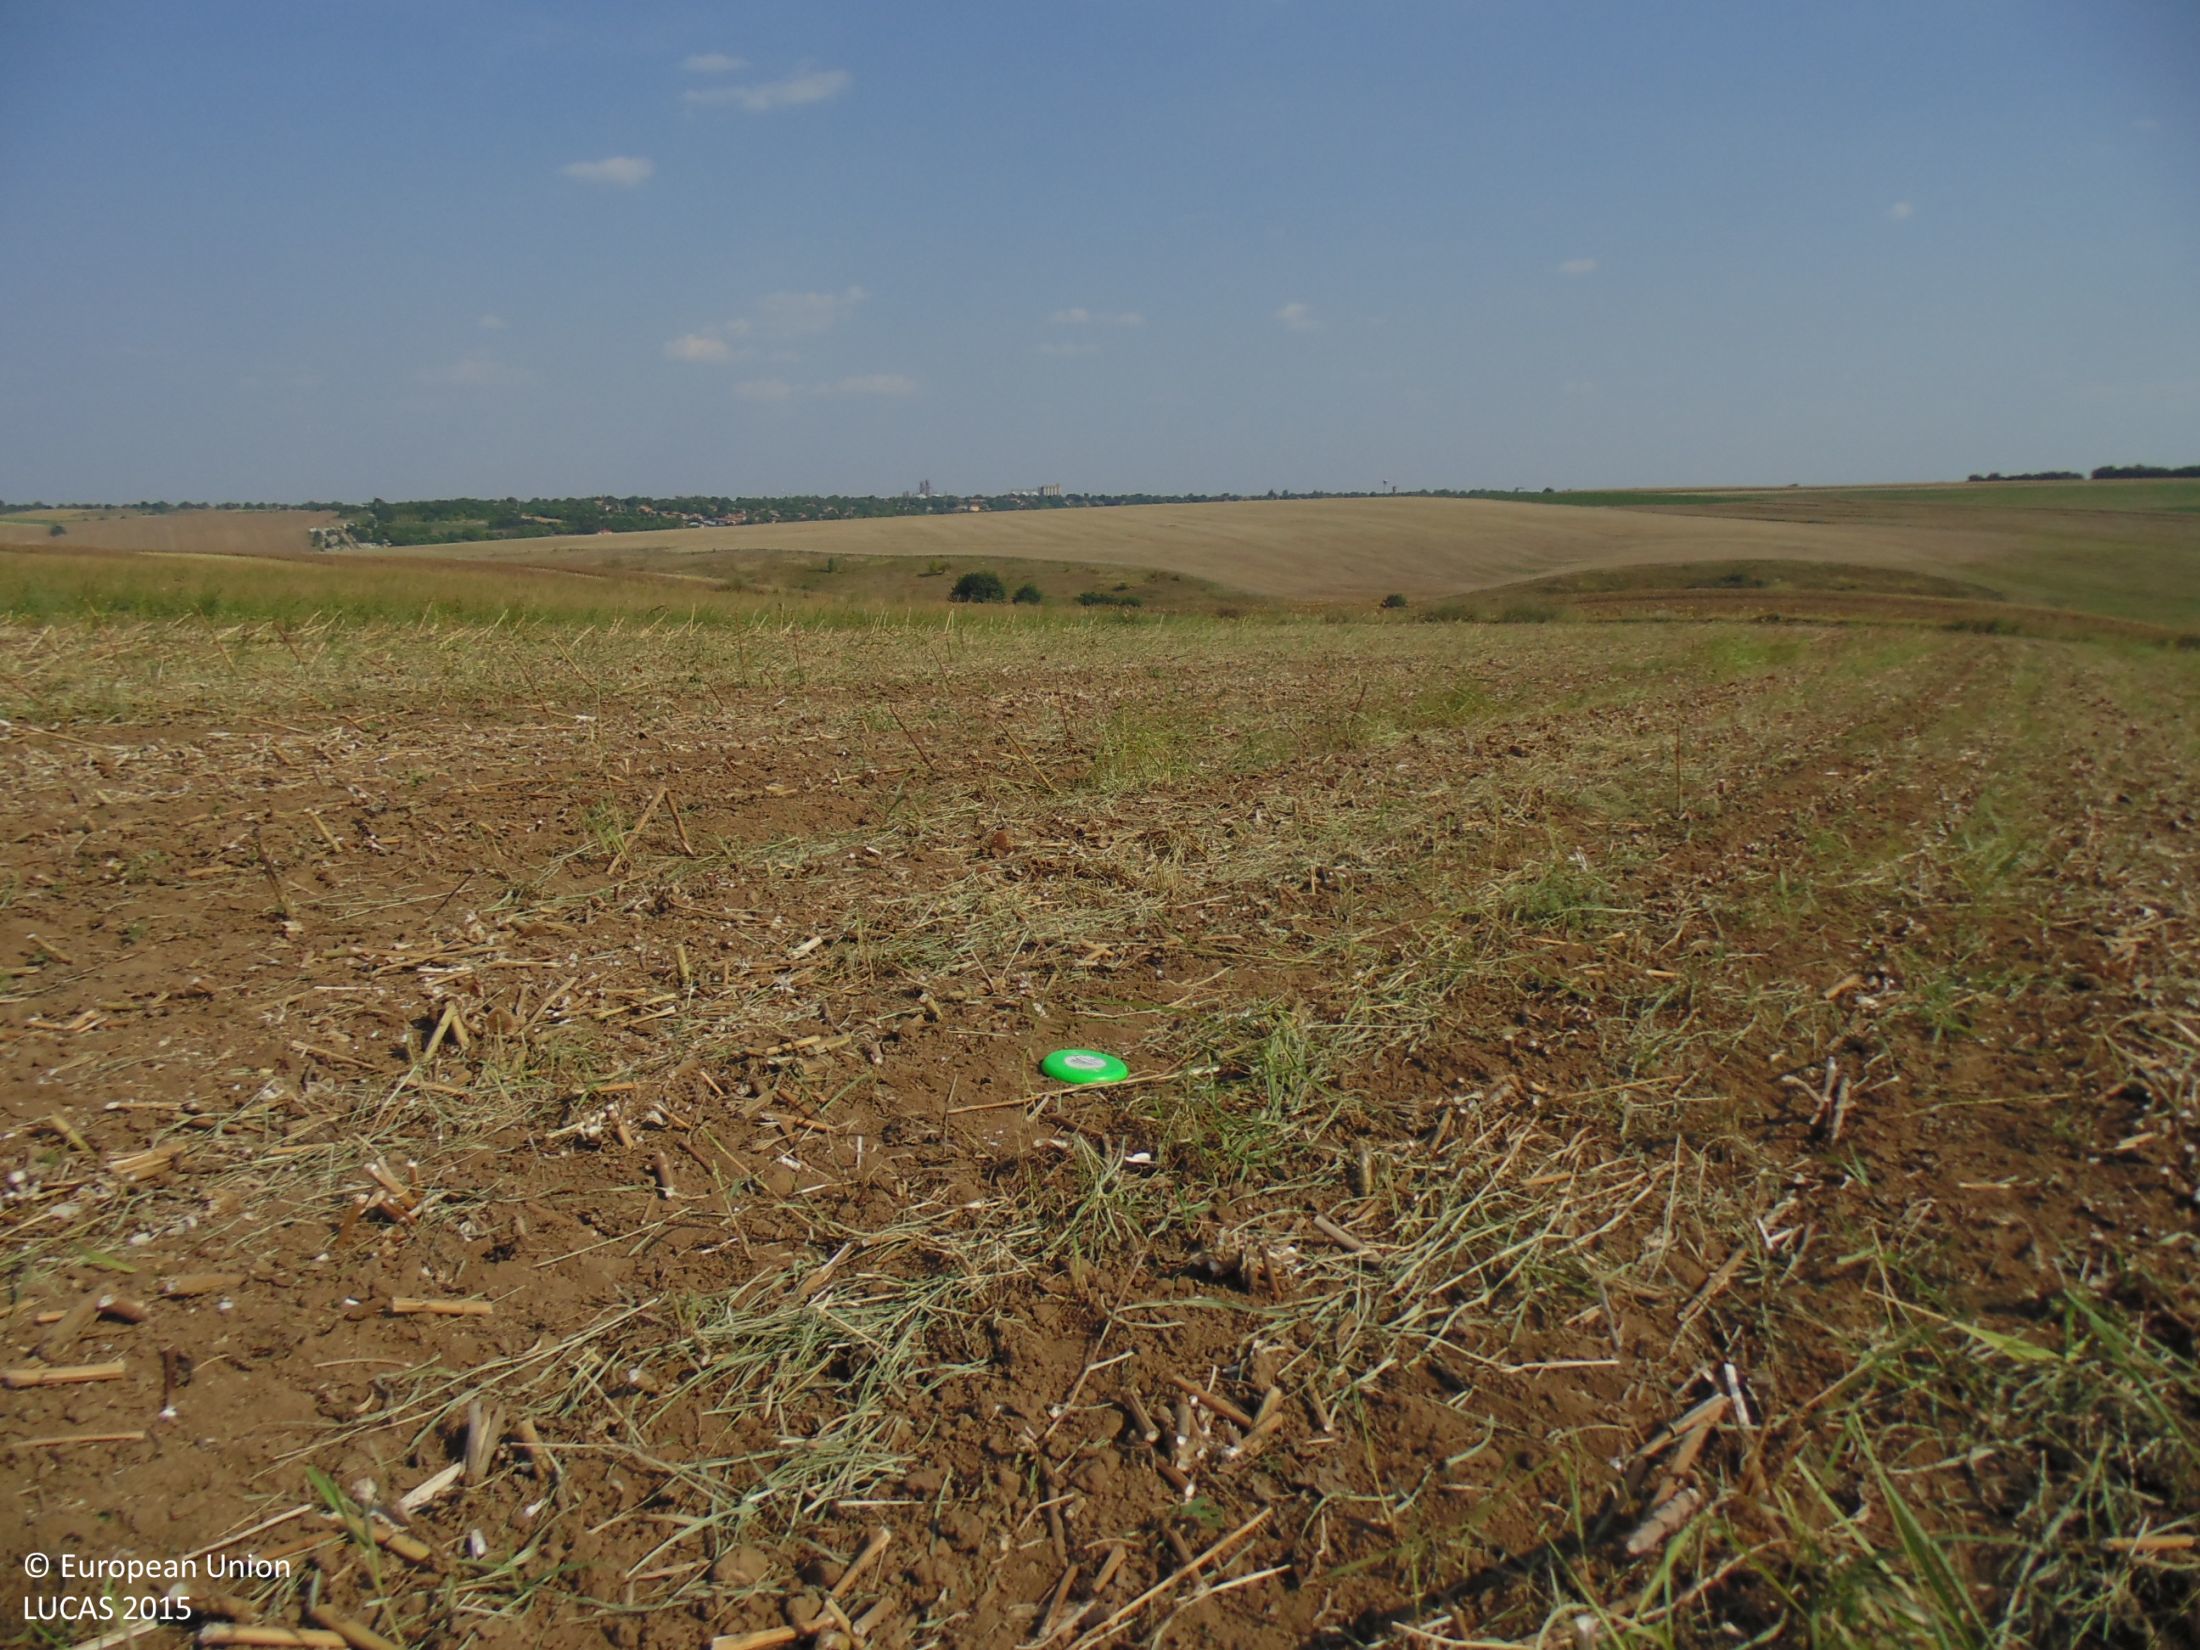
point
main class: Cropland
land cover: Sunflower
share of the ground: < 10 %
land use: Agriculture (excluding fallow land and kitchen gardens)
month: August
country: BG
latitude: 43.9579
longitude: 27.2654
